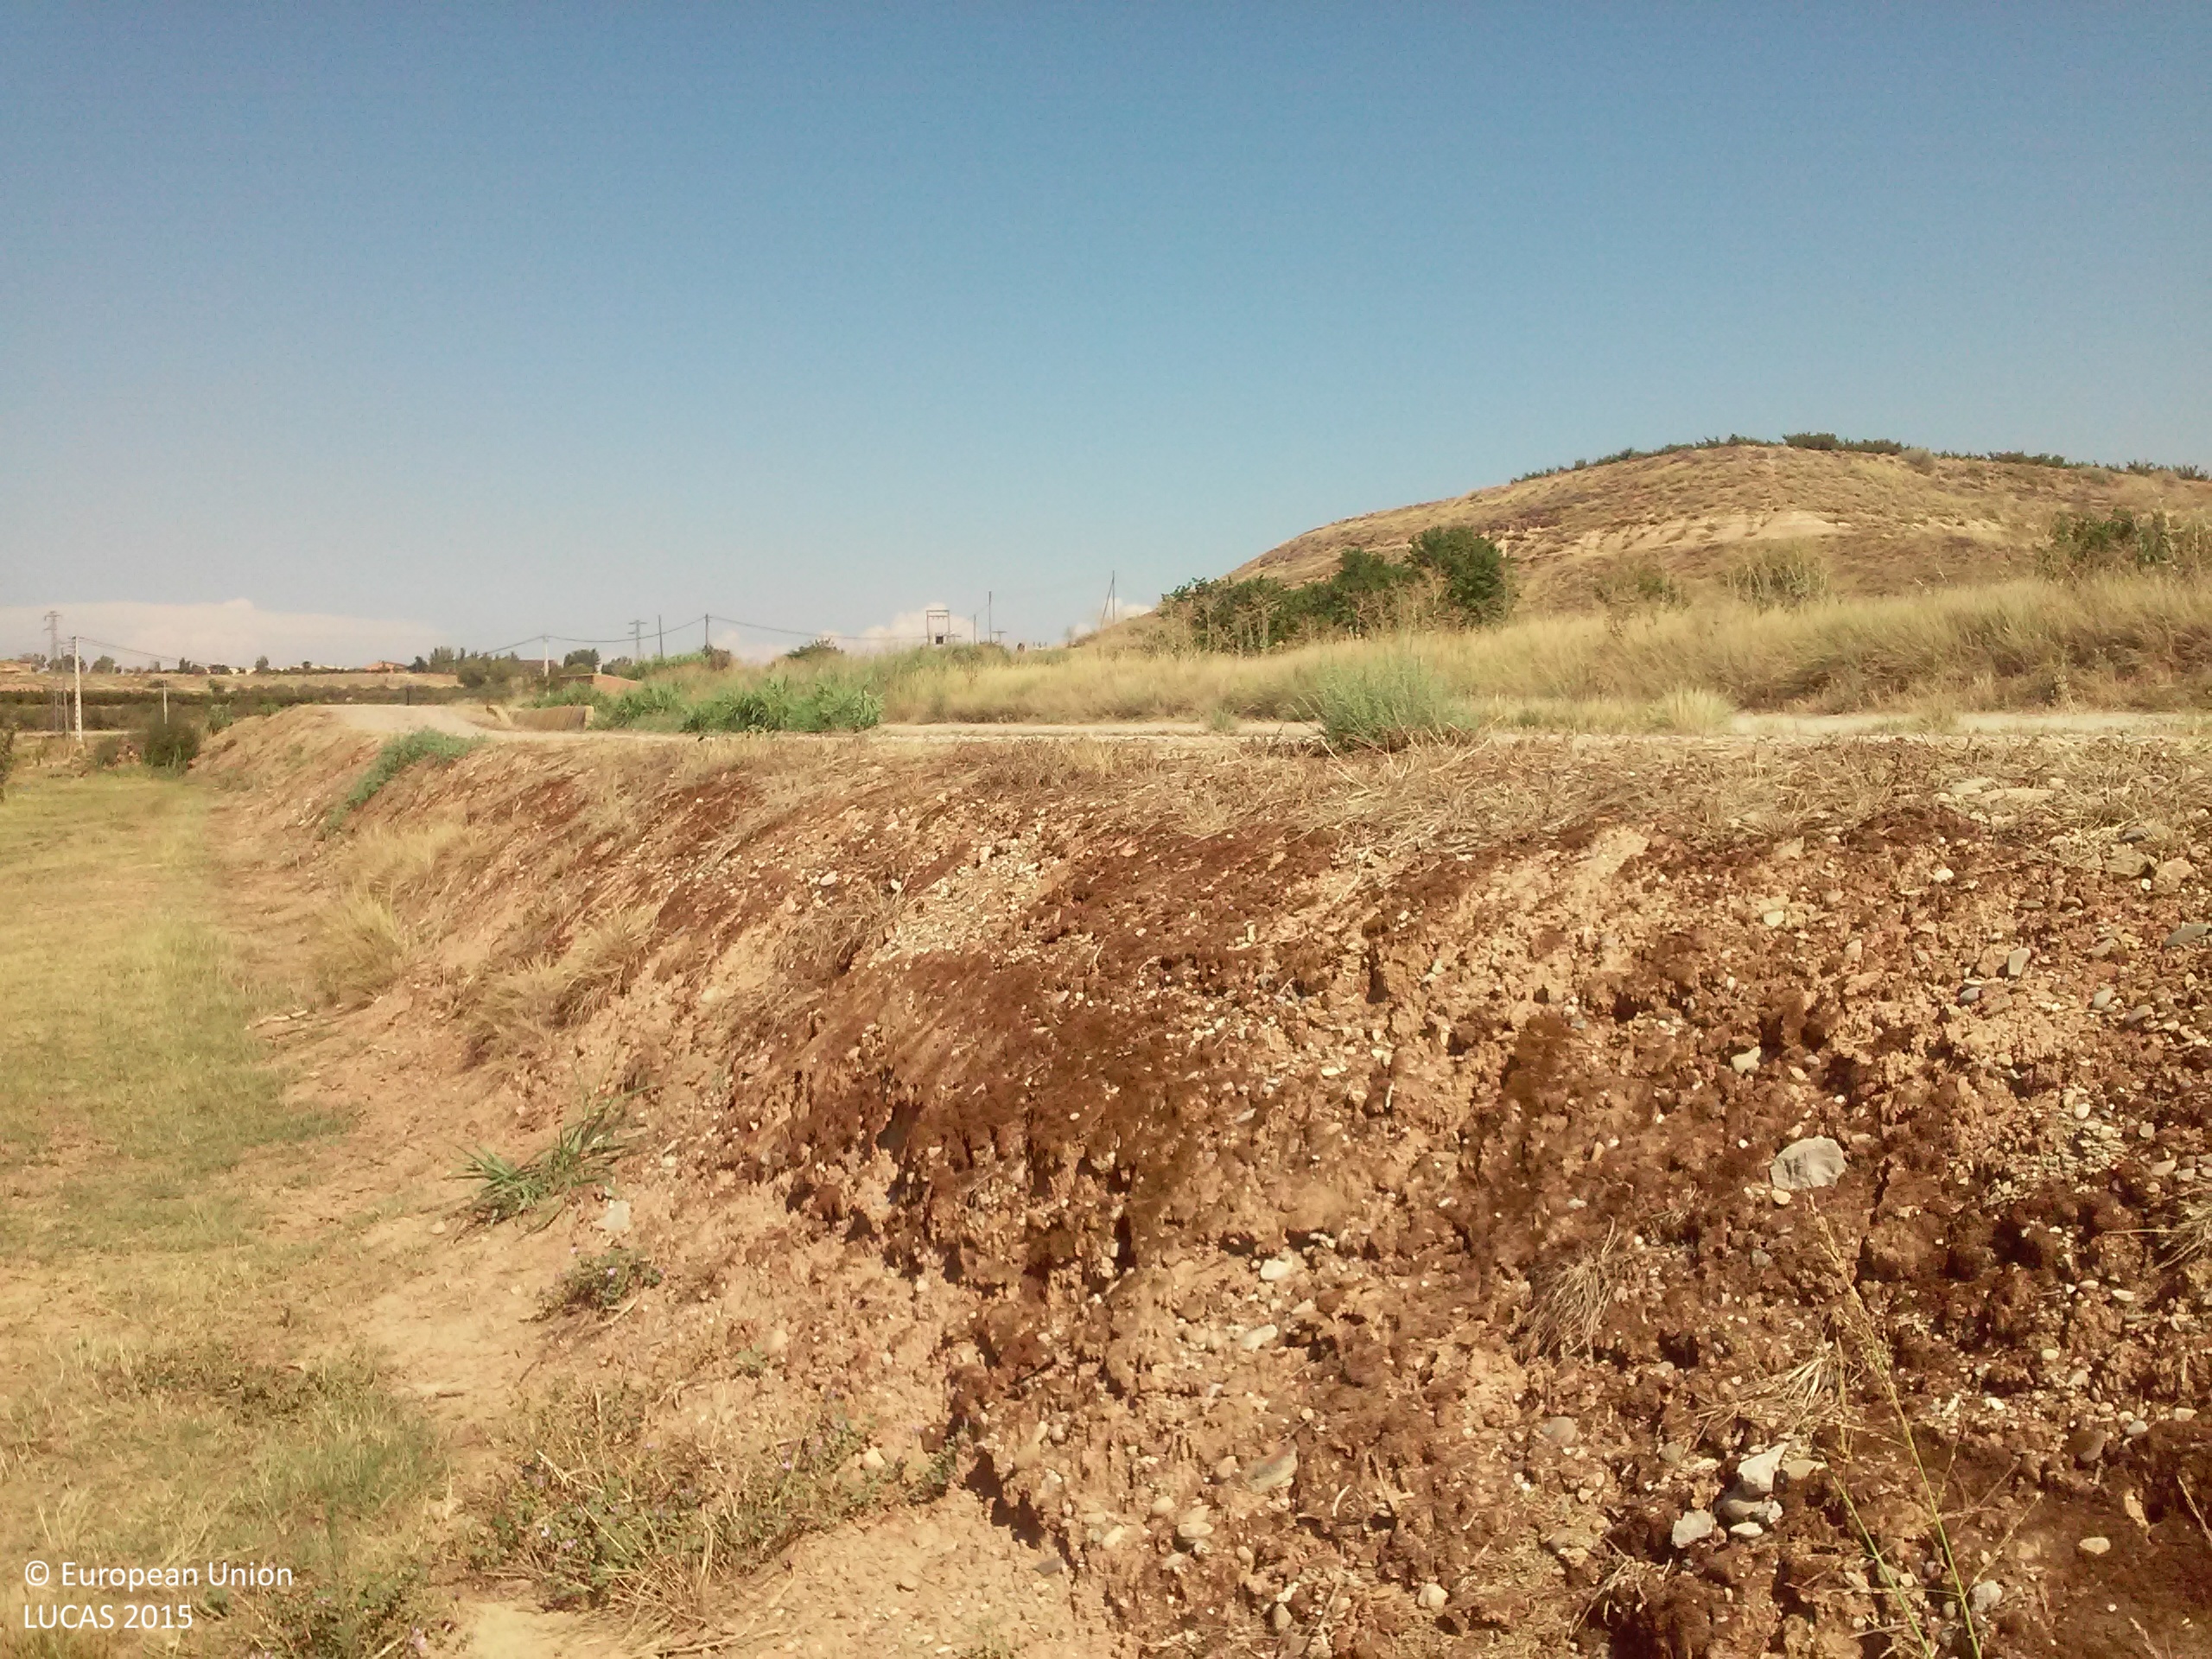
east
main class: Cropland
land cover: Apple fruit
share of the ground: 10 - 25 %
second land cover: Grassland without tree/shrub cover
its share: > 75 %
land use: Agriculture (excluding fallow land and kitchen gardens)
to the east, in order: Apple fruit; Grassland without tree/shrub cover; Grass margins; Tracks; Ditches and canals; Tracks; Barley; Grassland without tree/shrub cover; Electric lines; Barley; Grass margins; Paved roads, cycling and walking lanes
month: July
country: ES
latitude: 41.5952
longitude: 0.5699
